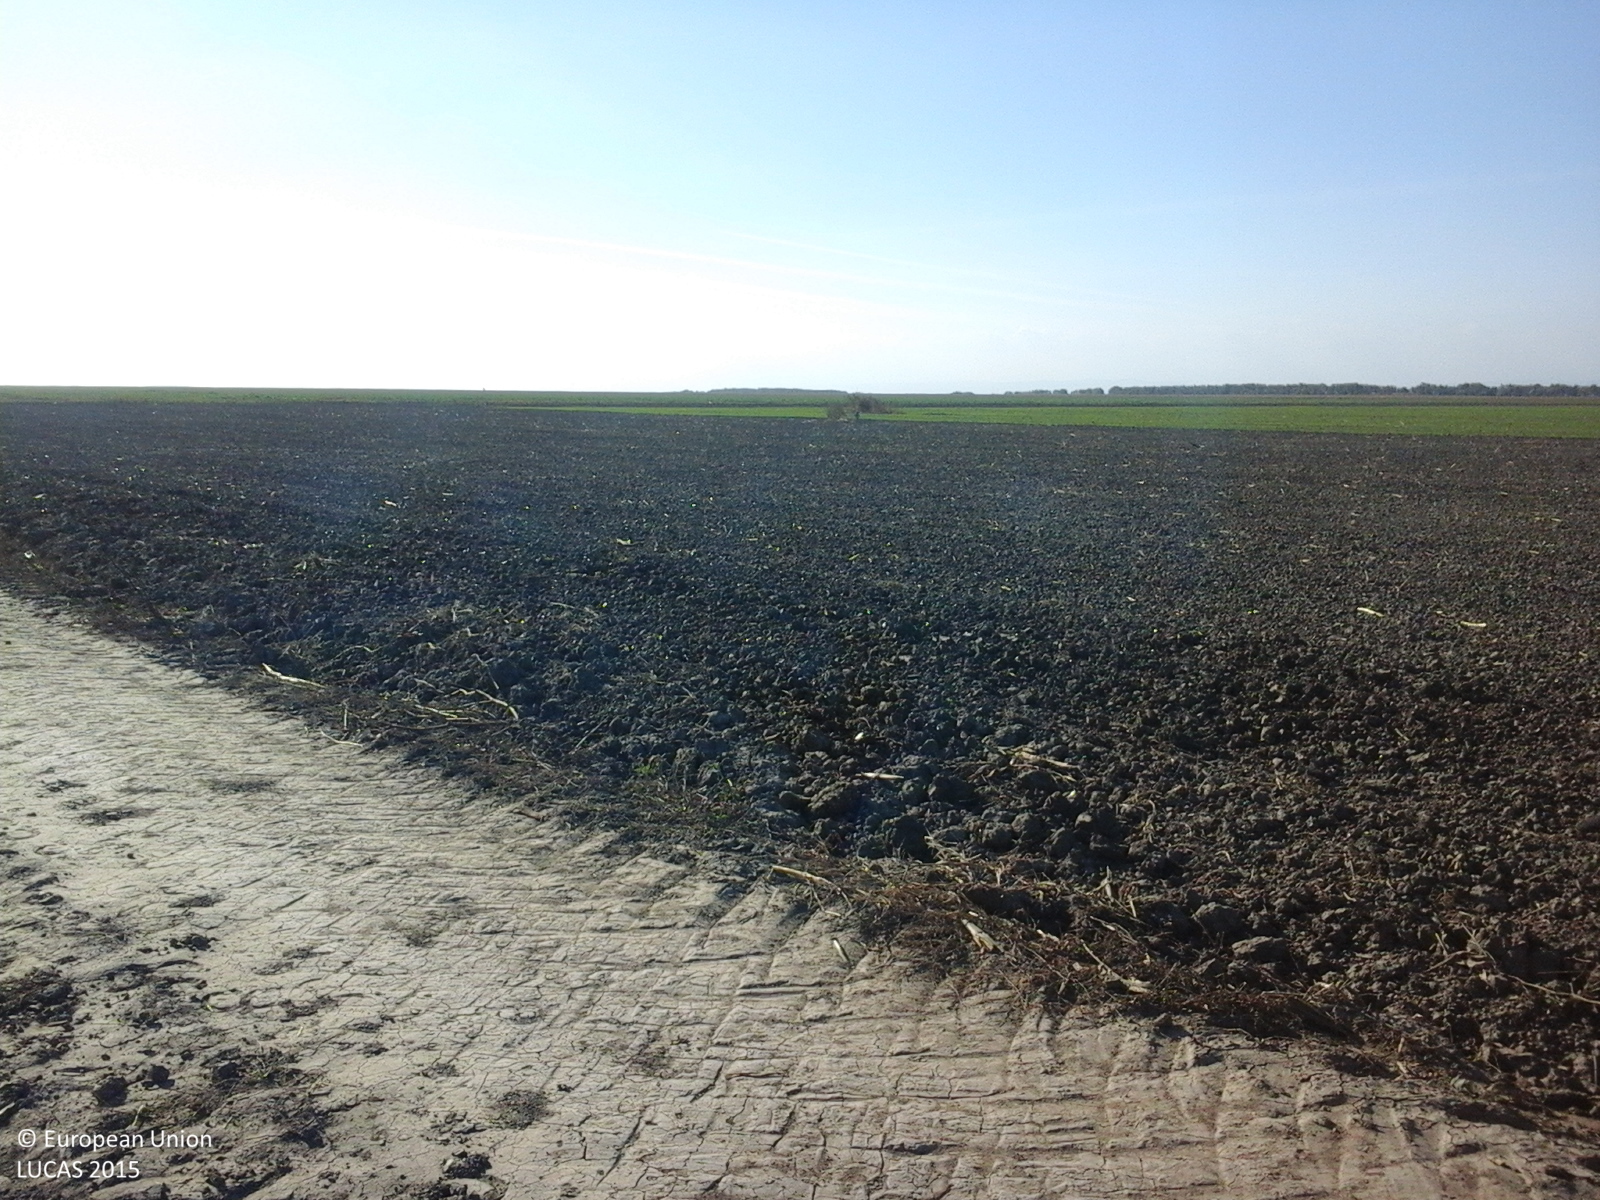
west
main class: Cropland
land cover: Common wheat
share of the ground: > 75 %
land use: Agriculture (excluding fallow land and kitchen gardens)
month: October
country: RO
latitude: 45.4194
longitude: 27.4415
